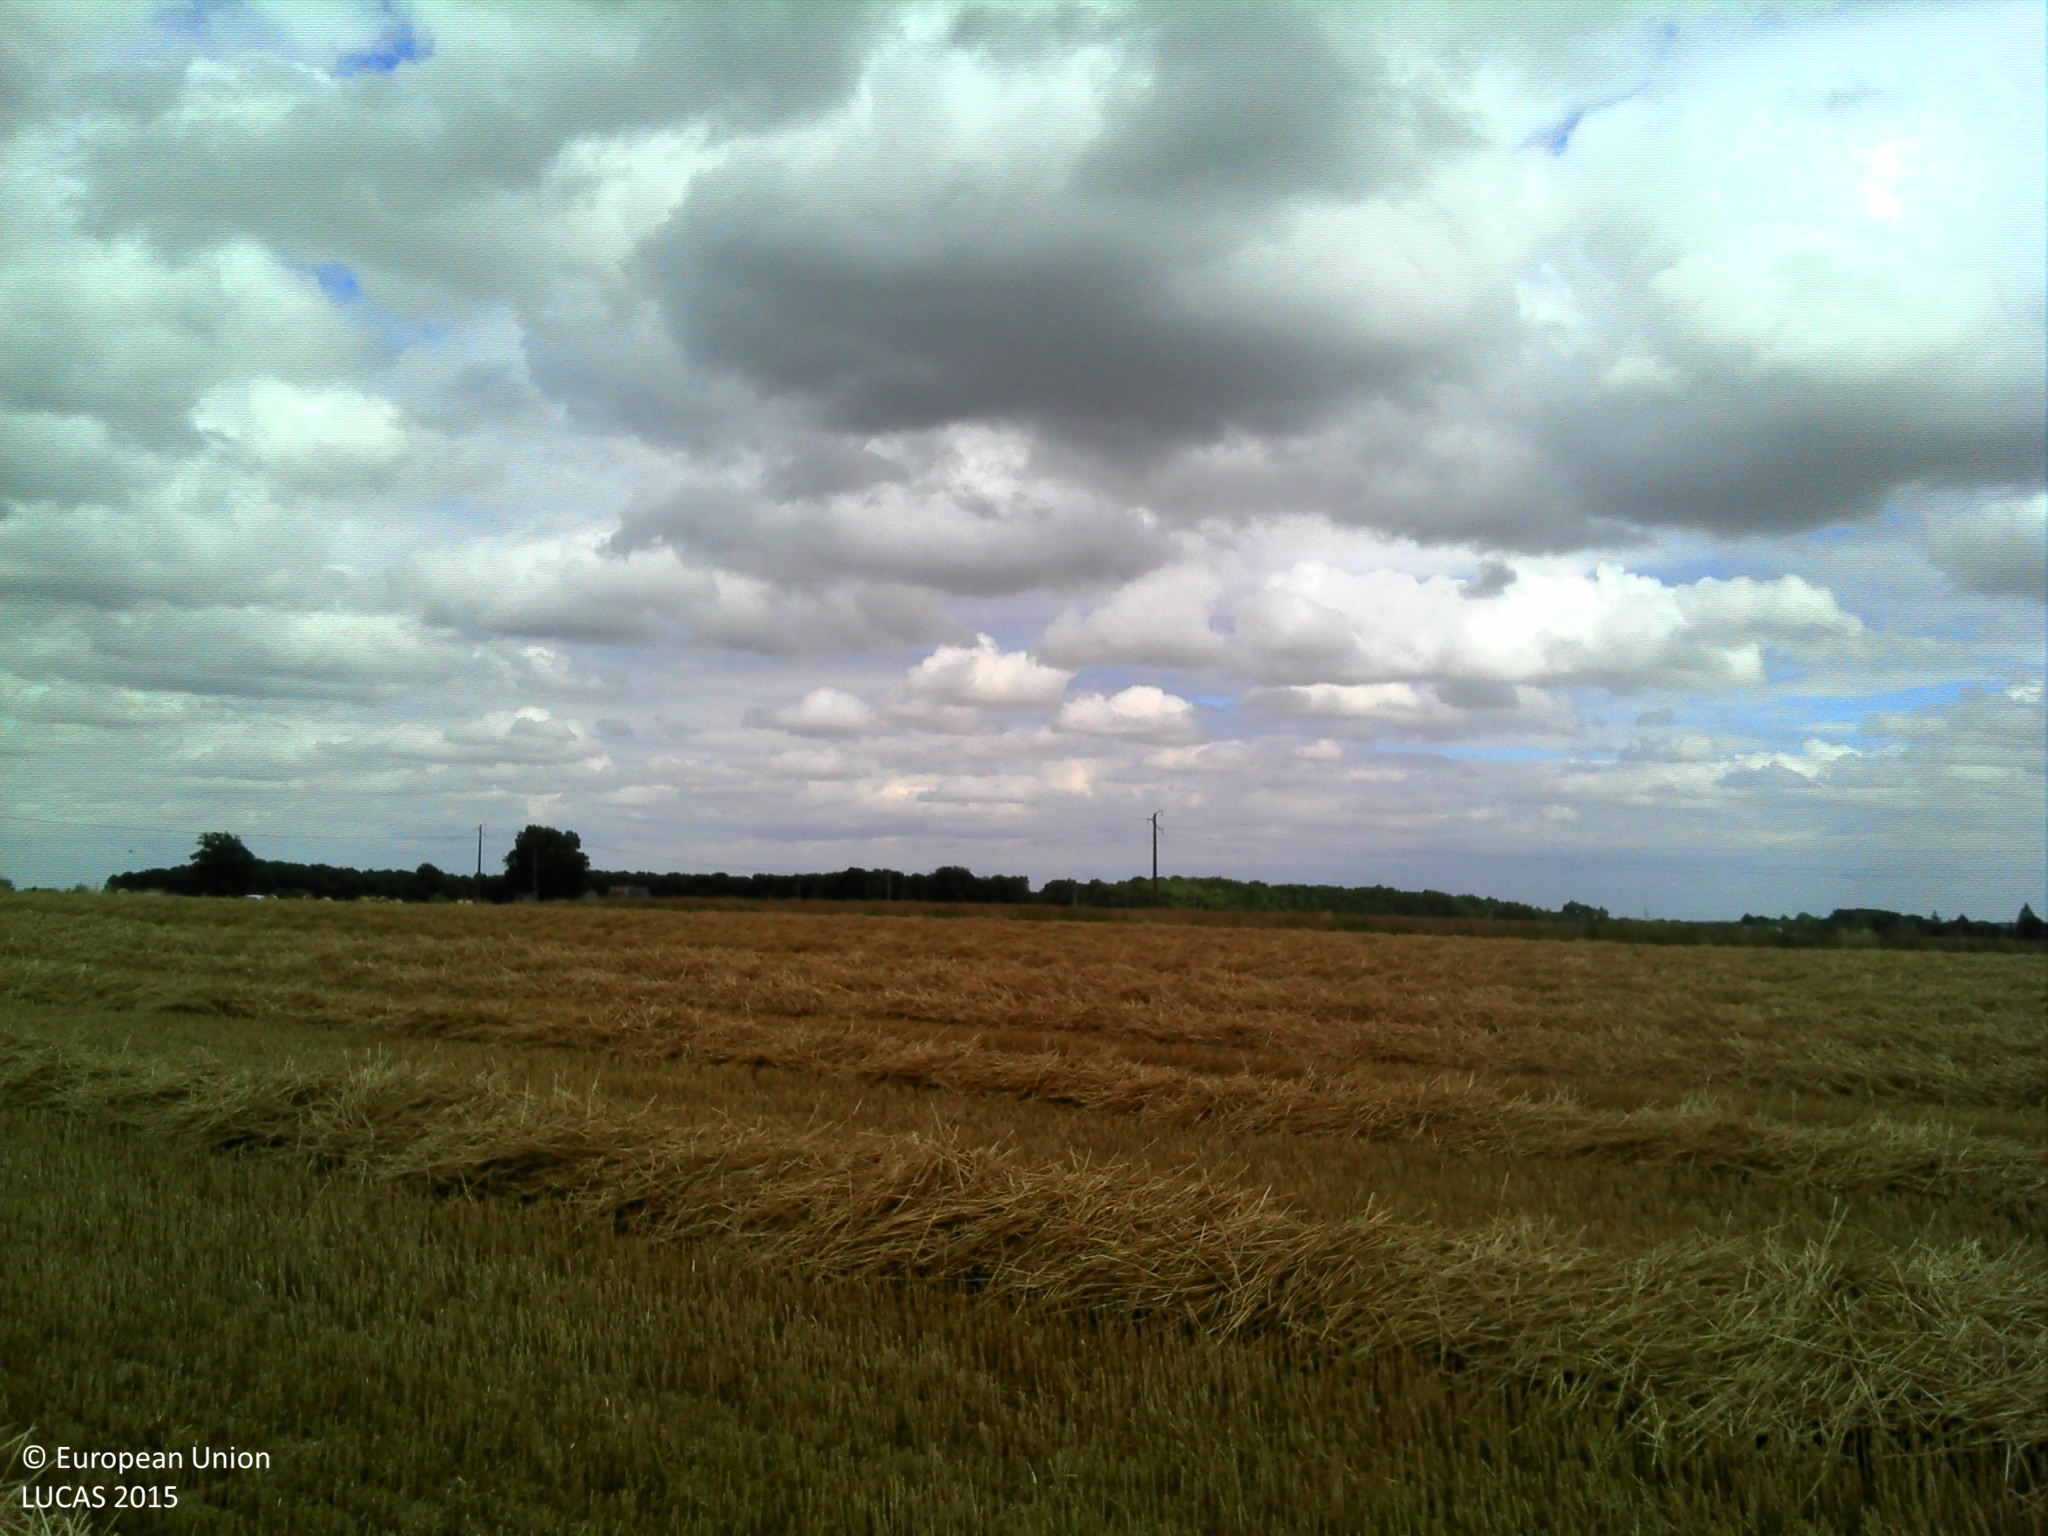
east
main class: Cropland
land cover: Common wheat
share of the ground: > 75 %
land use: Agriculture (excluding fallow land and kitchen gardens)
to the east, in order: Common wheat; Ditches and canals; Grass margins; Tracks; Grass margins; Ditches and canals; Rape and turnip rape; Electric lines; Grass margins; Ditches and canals; Grass margins; Paved roads, cycling and walking lanes; Grass margins; Ditches and canals; Common wheat
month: July
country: FR
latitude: 47.7171
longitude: 0.4462
